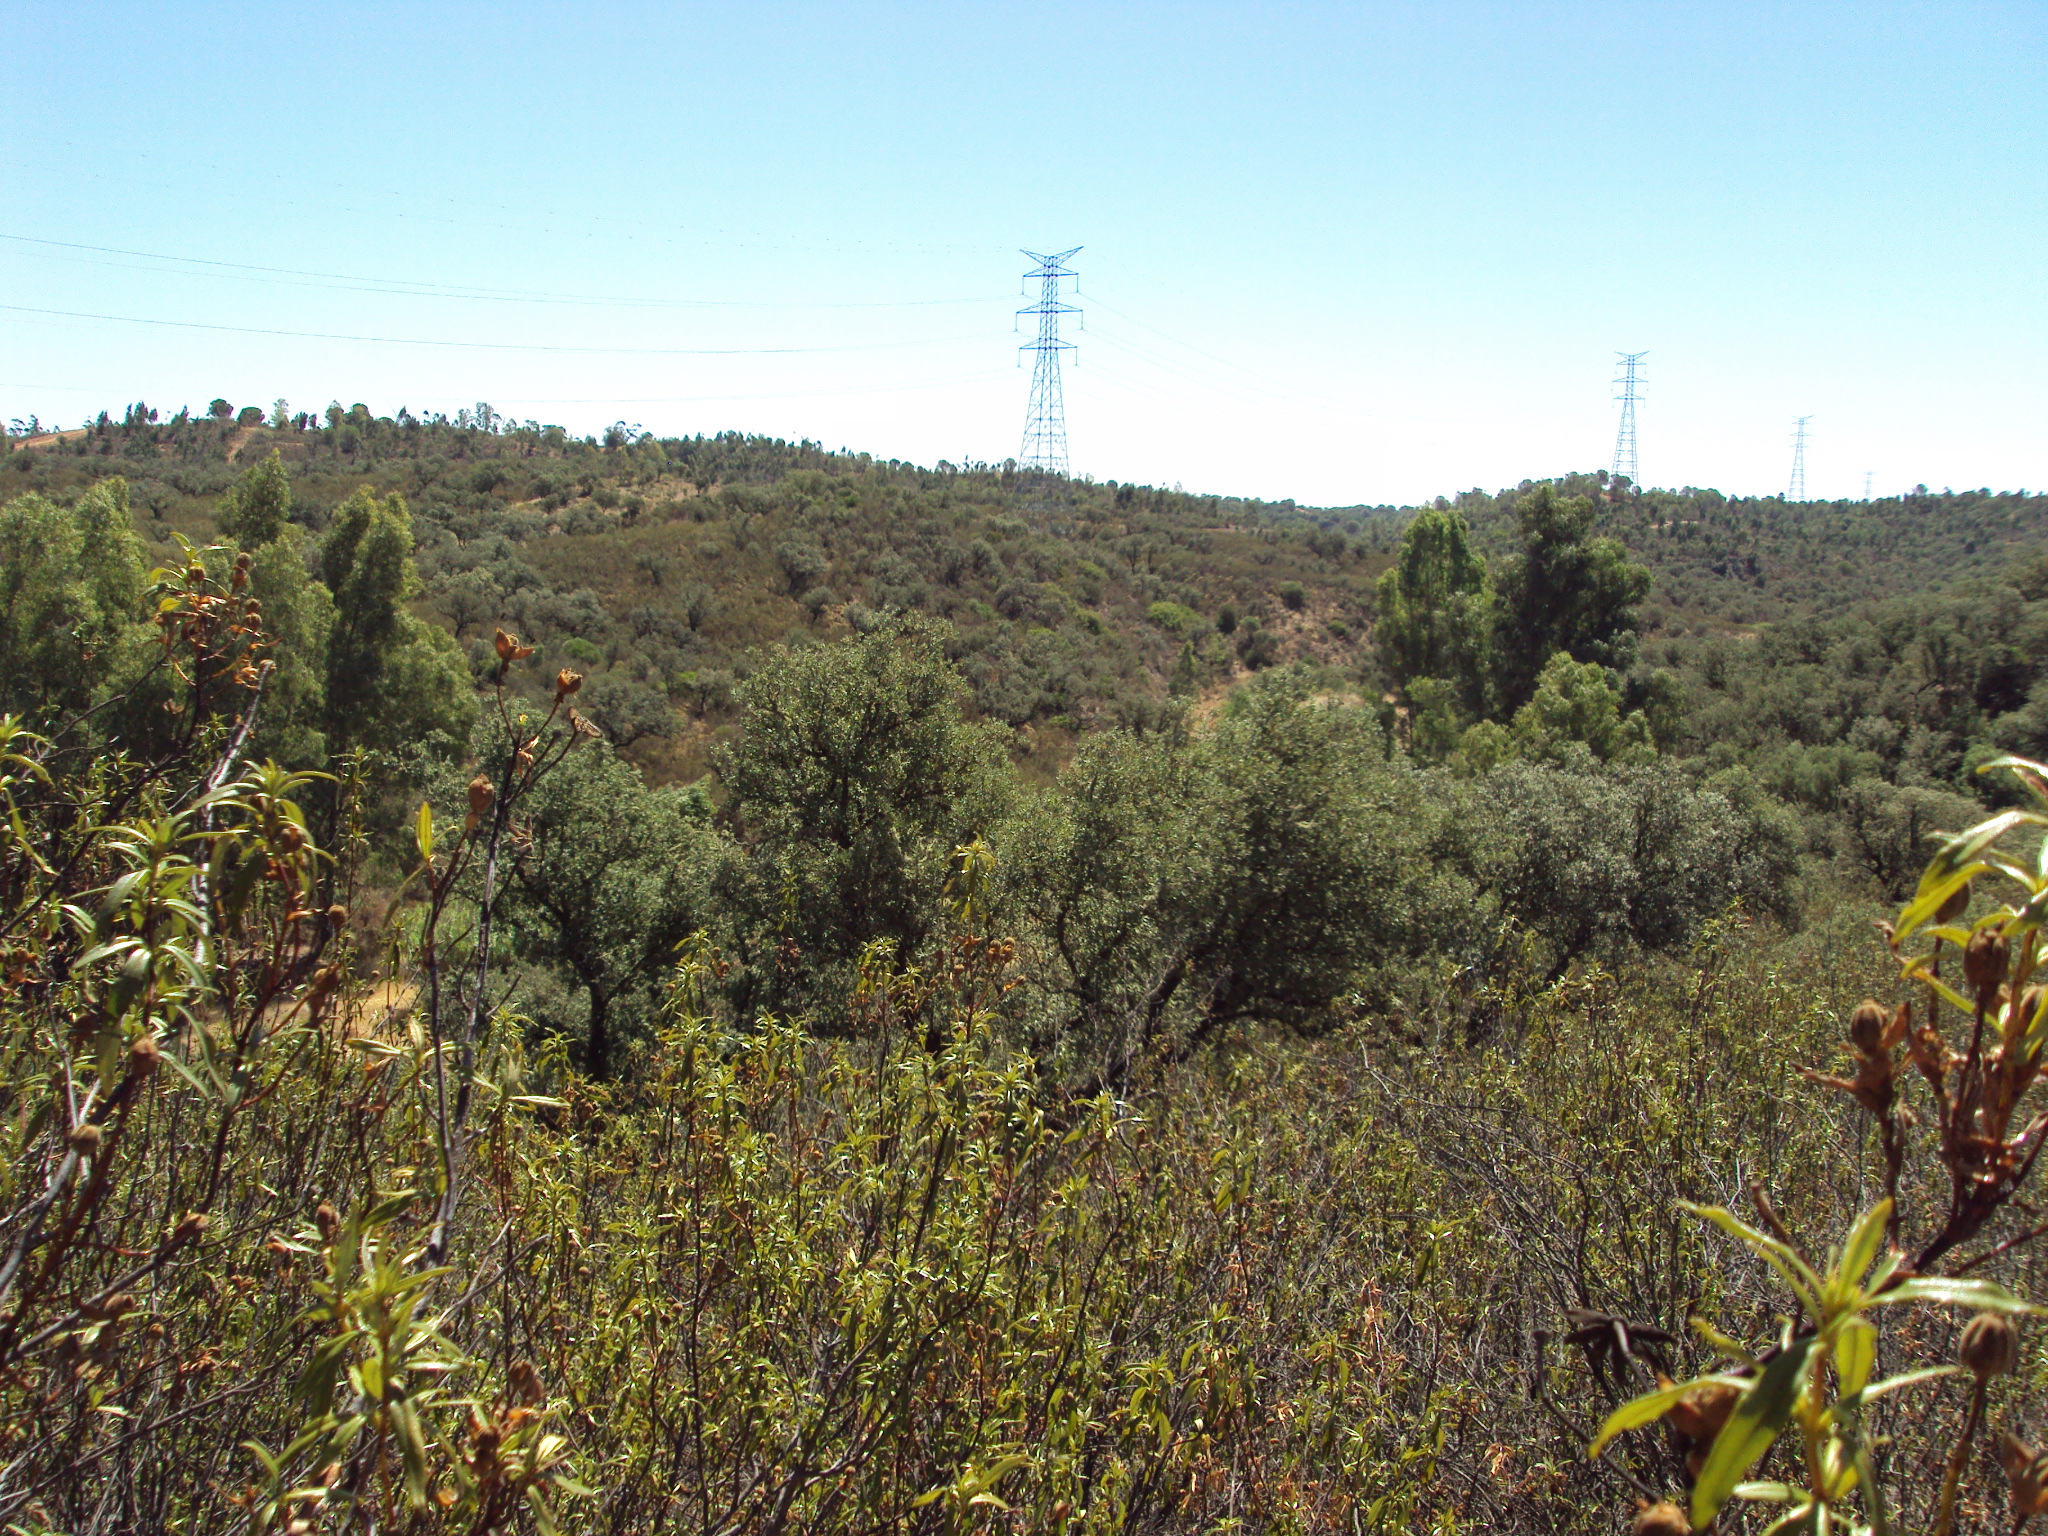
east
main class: Woodland
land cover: Broadleaved woodland
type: broadleaved evergreen forest
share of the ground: 10 - 25 %
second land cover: Spontaneously vegetated surfaces
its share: > 75 %
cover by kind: shrubs 80 %, broadleaved forest trees 20 %
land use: Forestry
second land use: Agriculture (excluding fallow land and kitchen gardens)
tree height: < 5 m
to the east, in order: Broadleaved woodland; Spontaneously vegetated surfaces; Rivers and streams; Broadleaved woodland
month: July
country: ES
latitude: 37.4507
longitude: -7.0569
